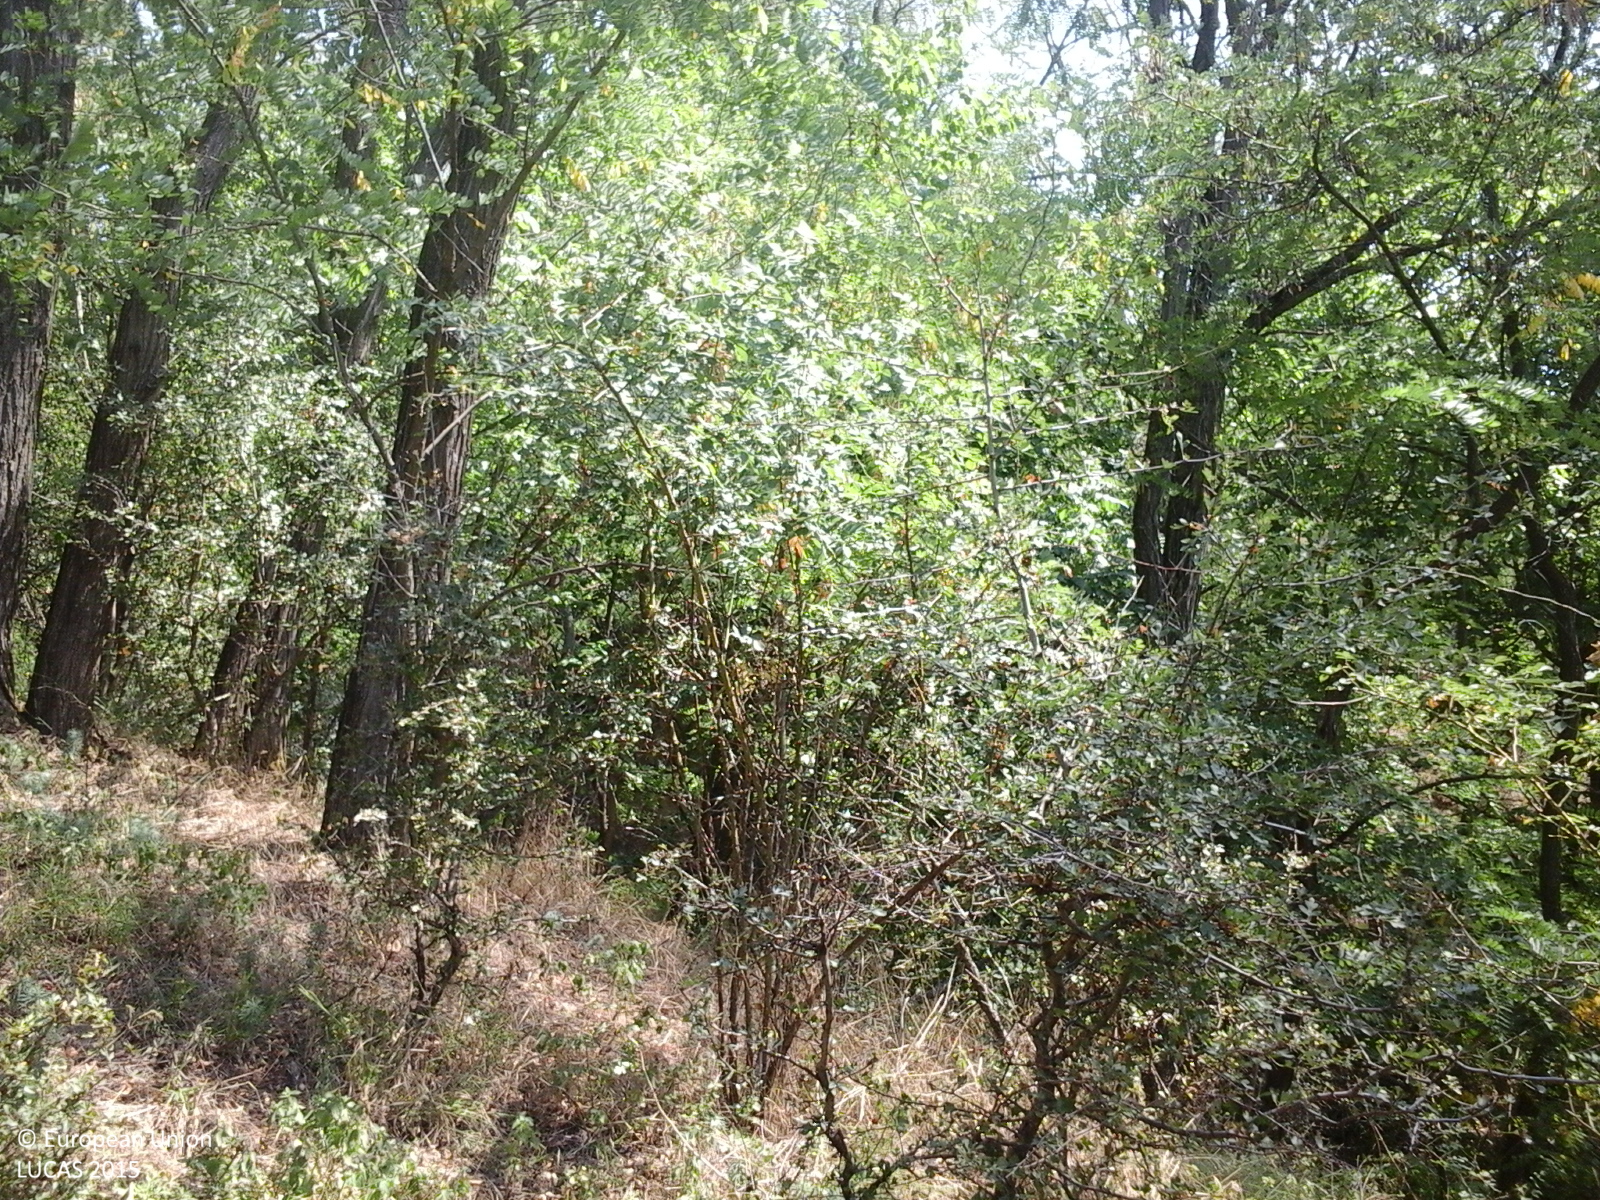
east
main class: Woodland
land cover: Broadleaved woodland
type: exotic forest
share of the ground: > 75 %
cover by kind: broadleaved forest trees 100 %
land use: Forestry
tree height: > 5 m
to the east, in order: Broadleaved woodland; Grassland with sparse tree/shrub cover; Broadleaved woodland; Tracks; Broadleaved woodland; Grassland with sparse tree/shrub cover; Rocks and stones; Grassland with sparse tree/shrub cover; Broadleaved woodland
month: August
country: RO
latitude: 46.1436
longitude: 27.0673
